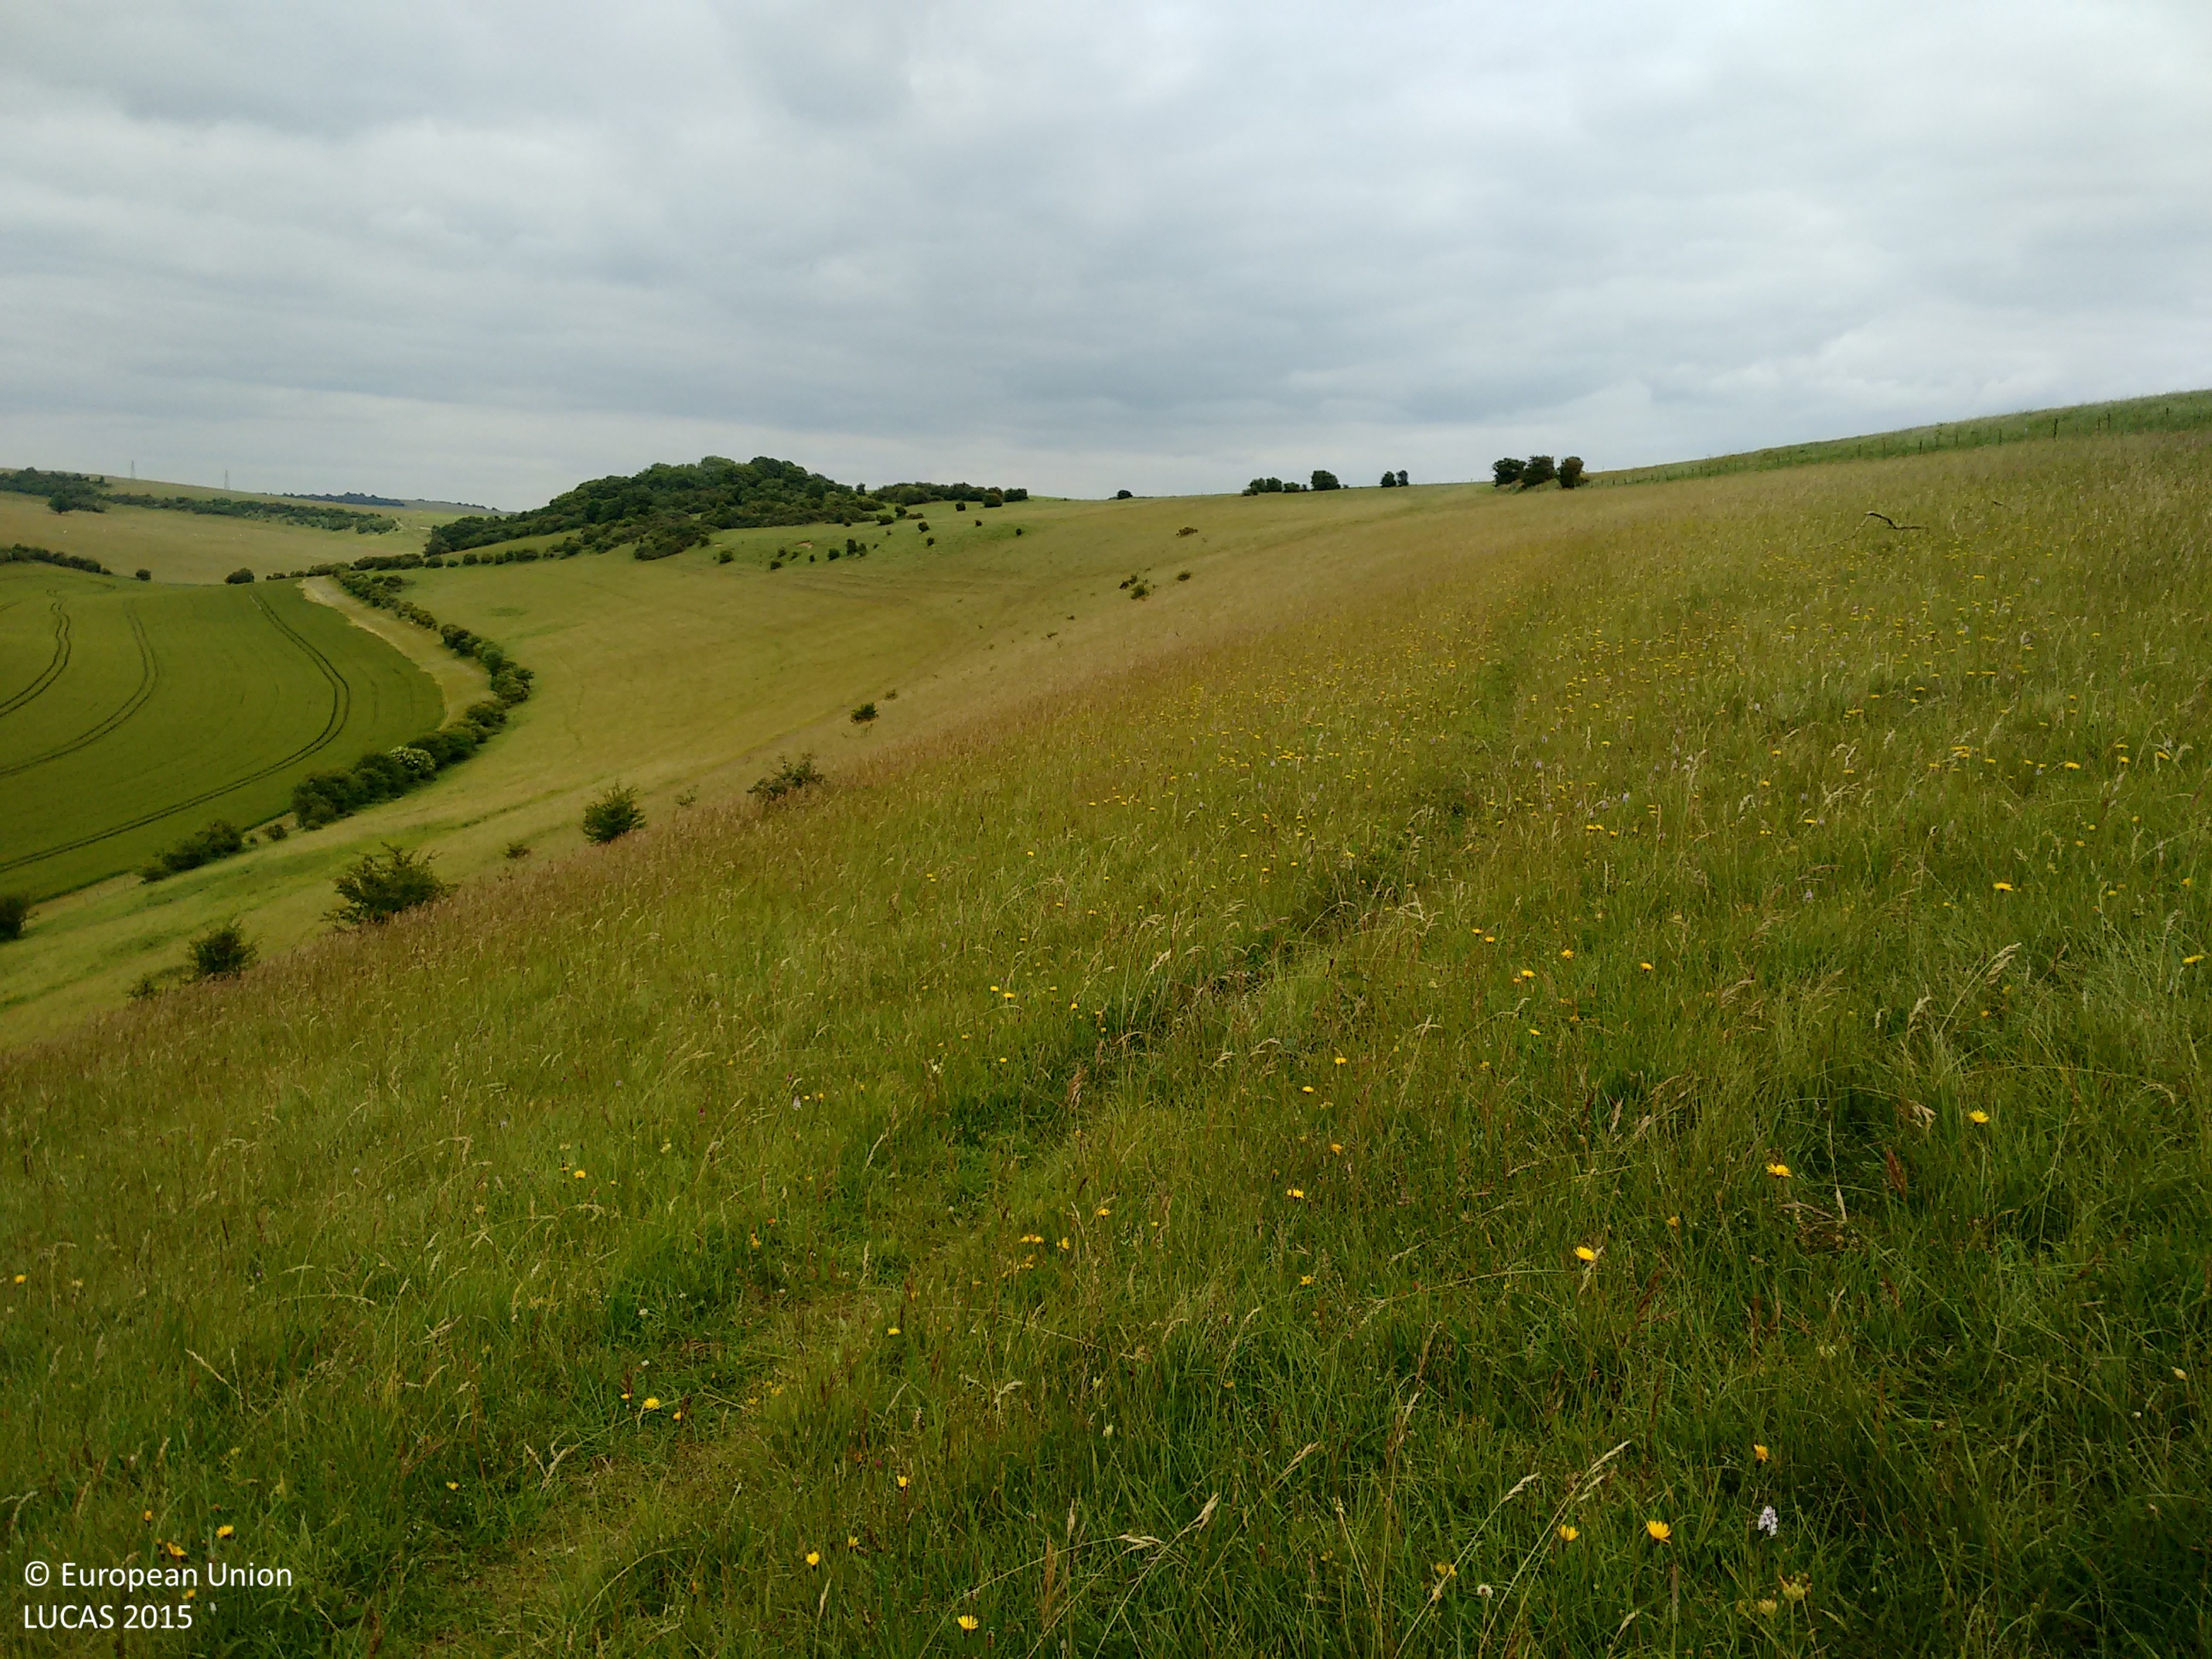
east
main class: Grassland
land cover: Grassland without tree/shrub cover
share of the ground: > 75 %
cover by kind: herbaceous plants 100 %
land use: Agriculture (excluding fallow land and kitchen gardens)
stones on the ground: < 10 %
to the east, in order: Grassland without tree/shrub cover
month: June
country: GB
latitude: 50.8780
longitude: -0.0818
